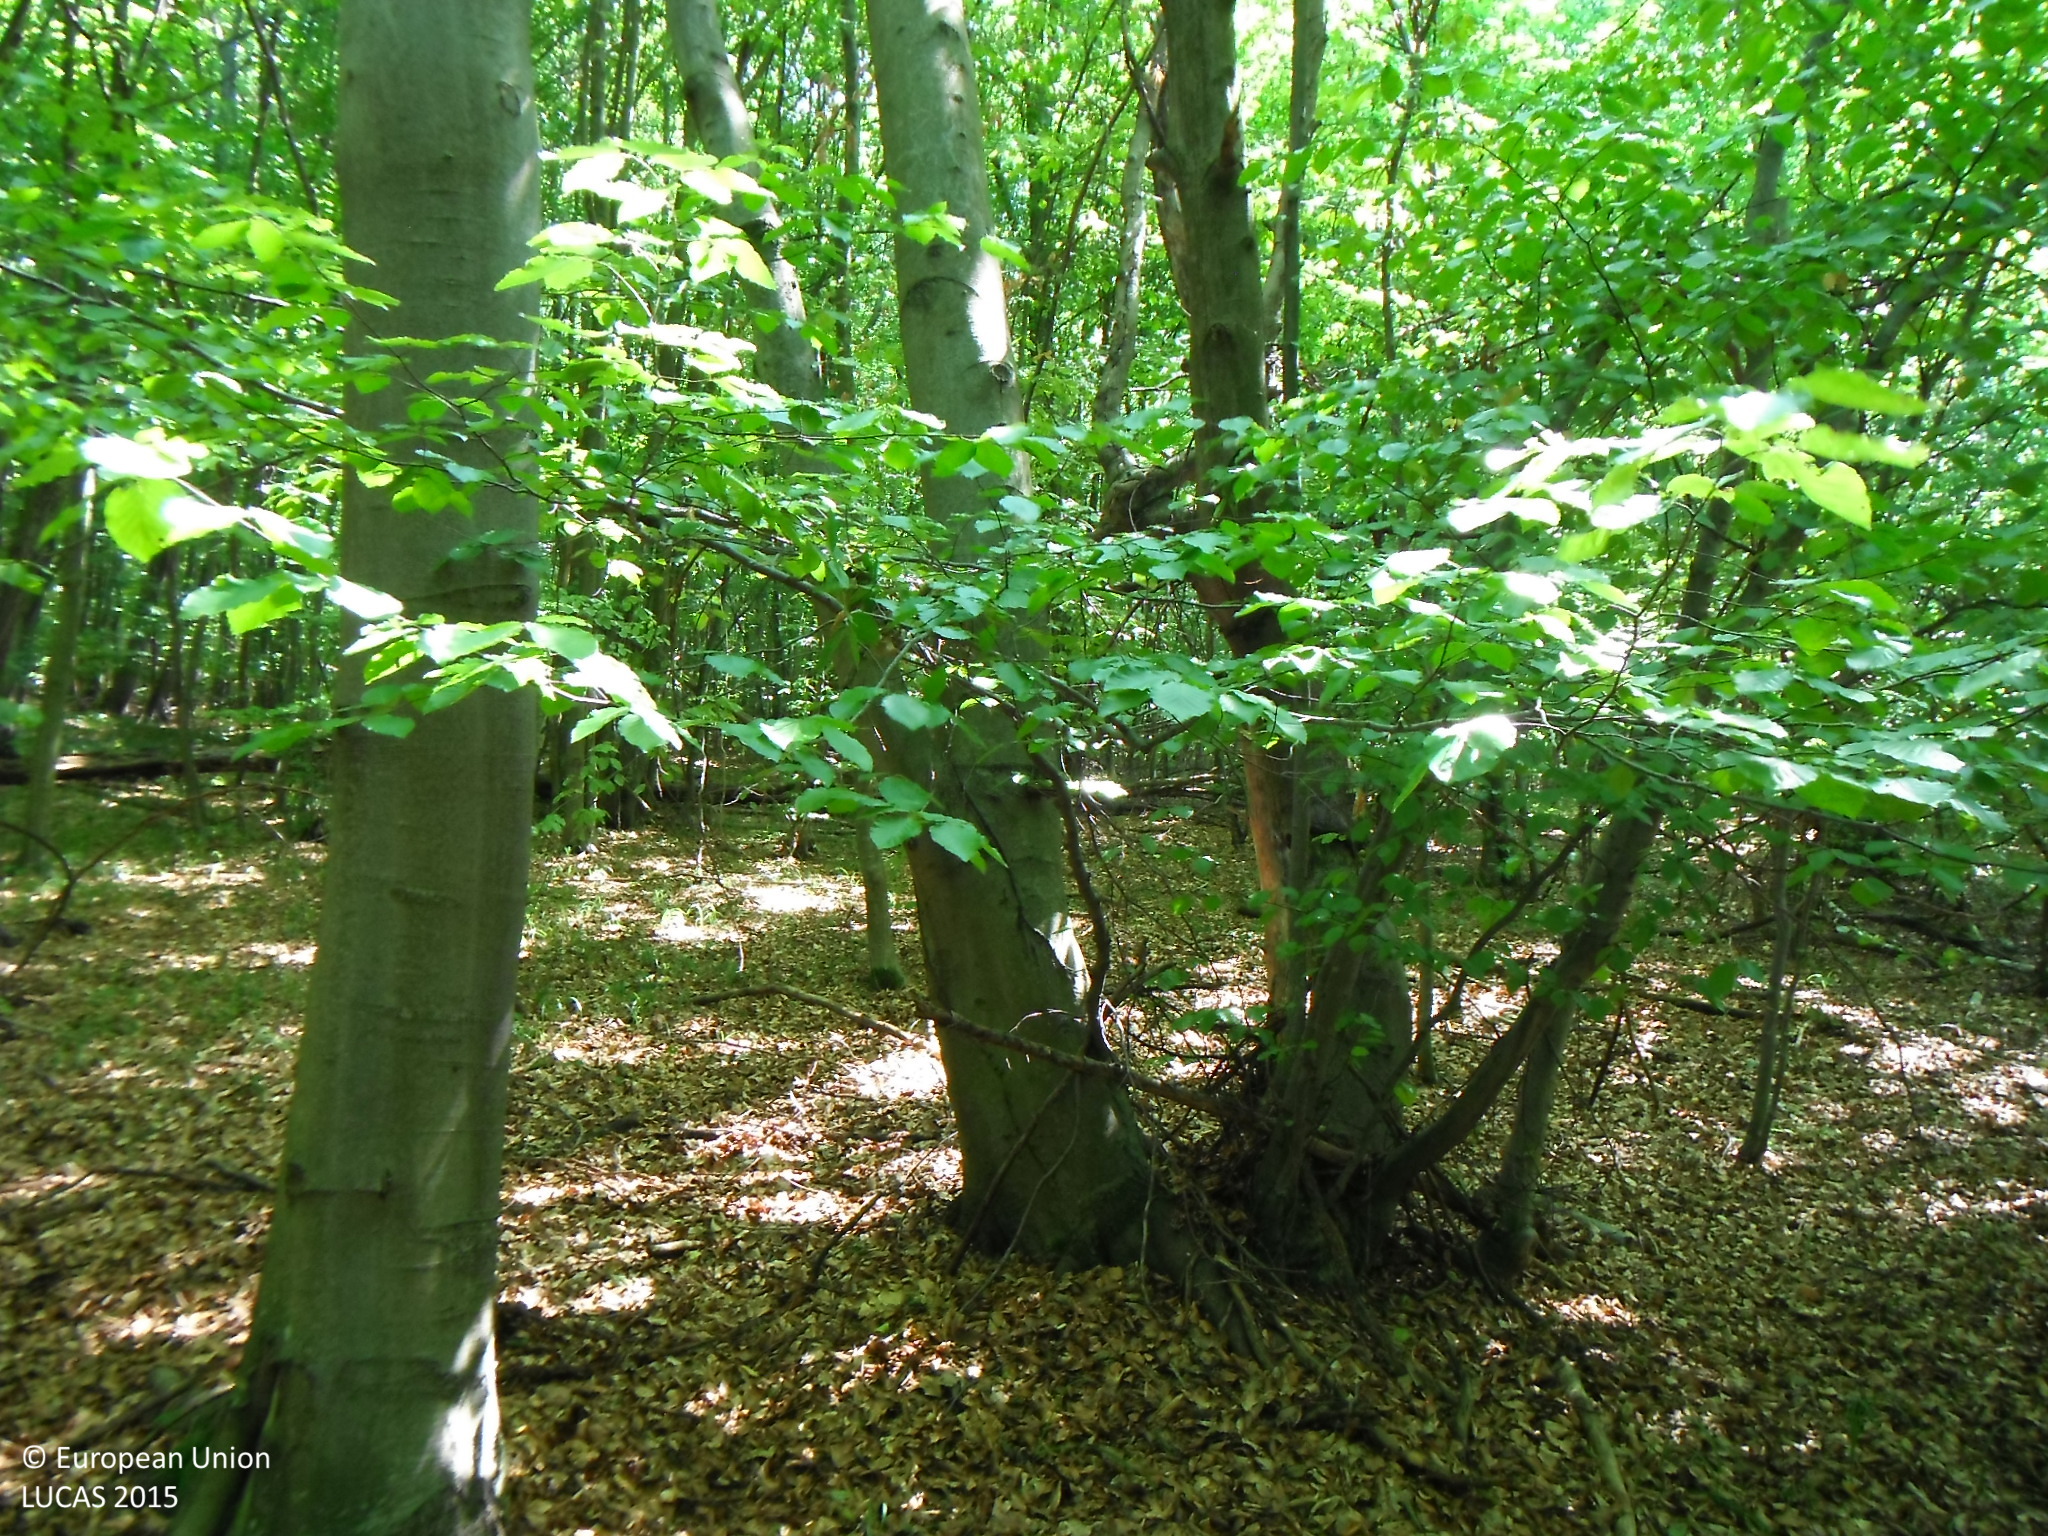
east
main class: Woodland
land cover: Broadleaved woodland
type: mesophytic deciduous forest
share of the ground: > 75 %
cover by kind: broadleaved forest trees 100 %
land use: Forestry
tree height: > 5 m
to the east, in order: Broadleaved woodland
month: August
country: SK
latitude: 49.1509
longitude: 21.9698
